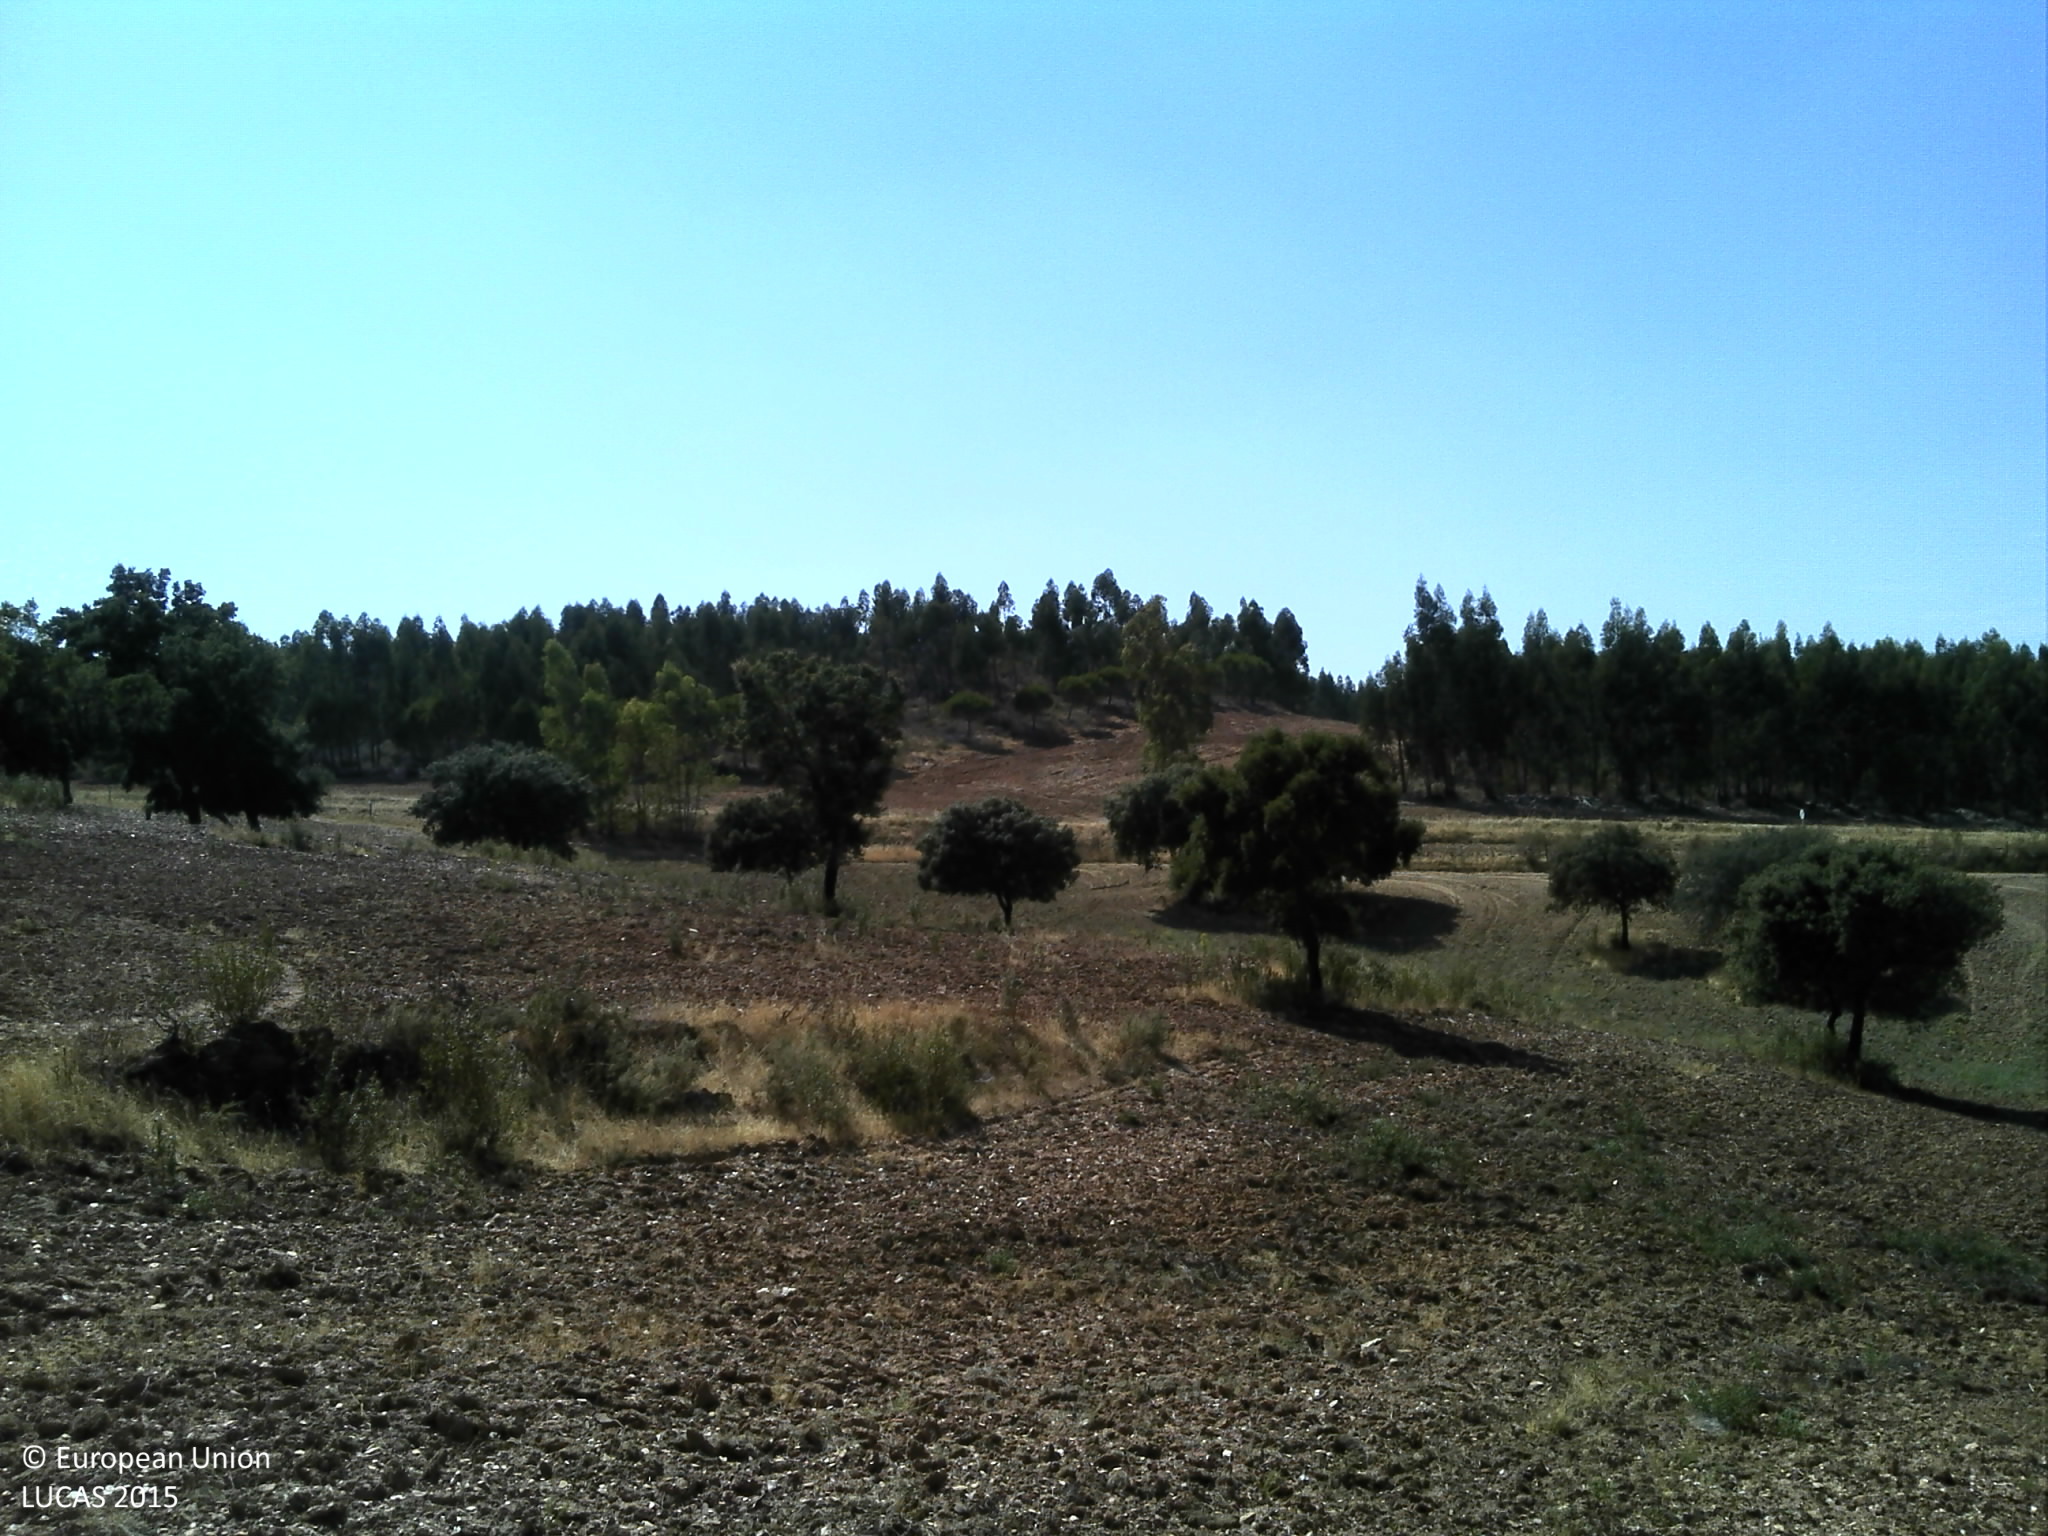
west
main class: Woodland
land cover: Broadleaved woodland
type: broadleaved evergreen forest
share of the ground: 10 - 25 %
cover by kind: unconsolidated bare surface 85 %, broadleaved forest trees 15 %
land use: Forestry
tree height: > 5 m
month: July
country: PT
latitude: 38.6994
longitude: -7.4980
